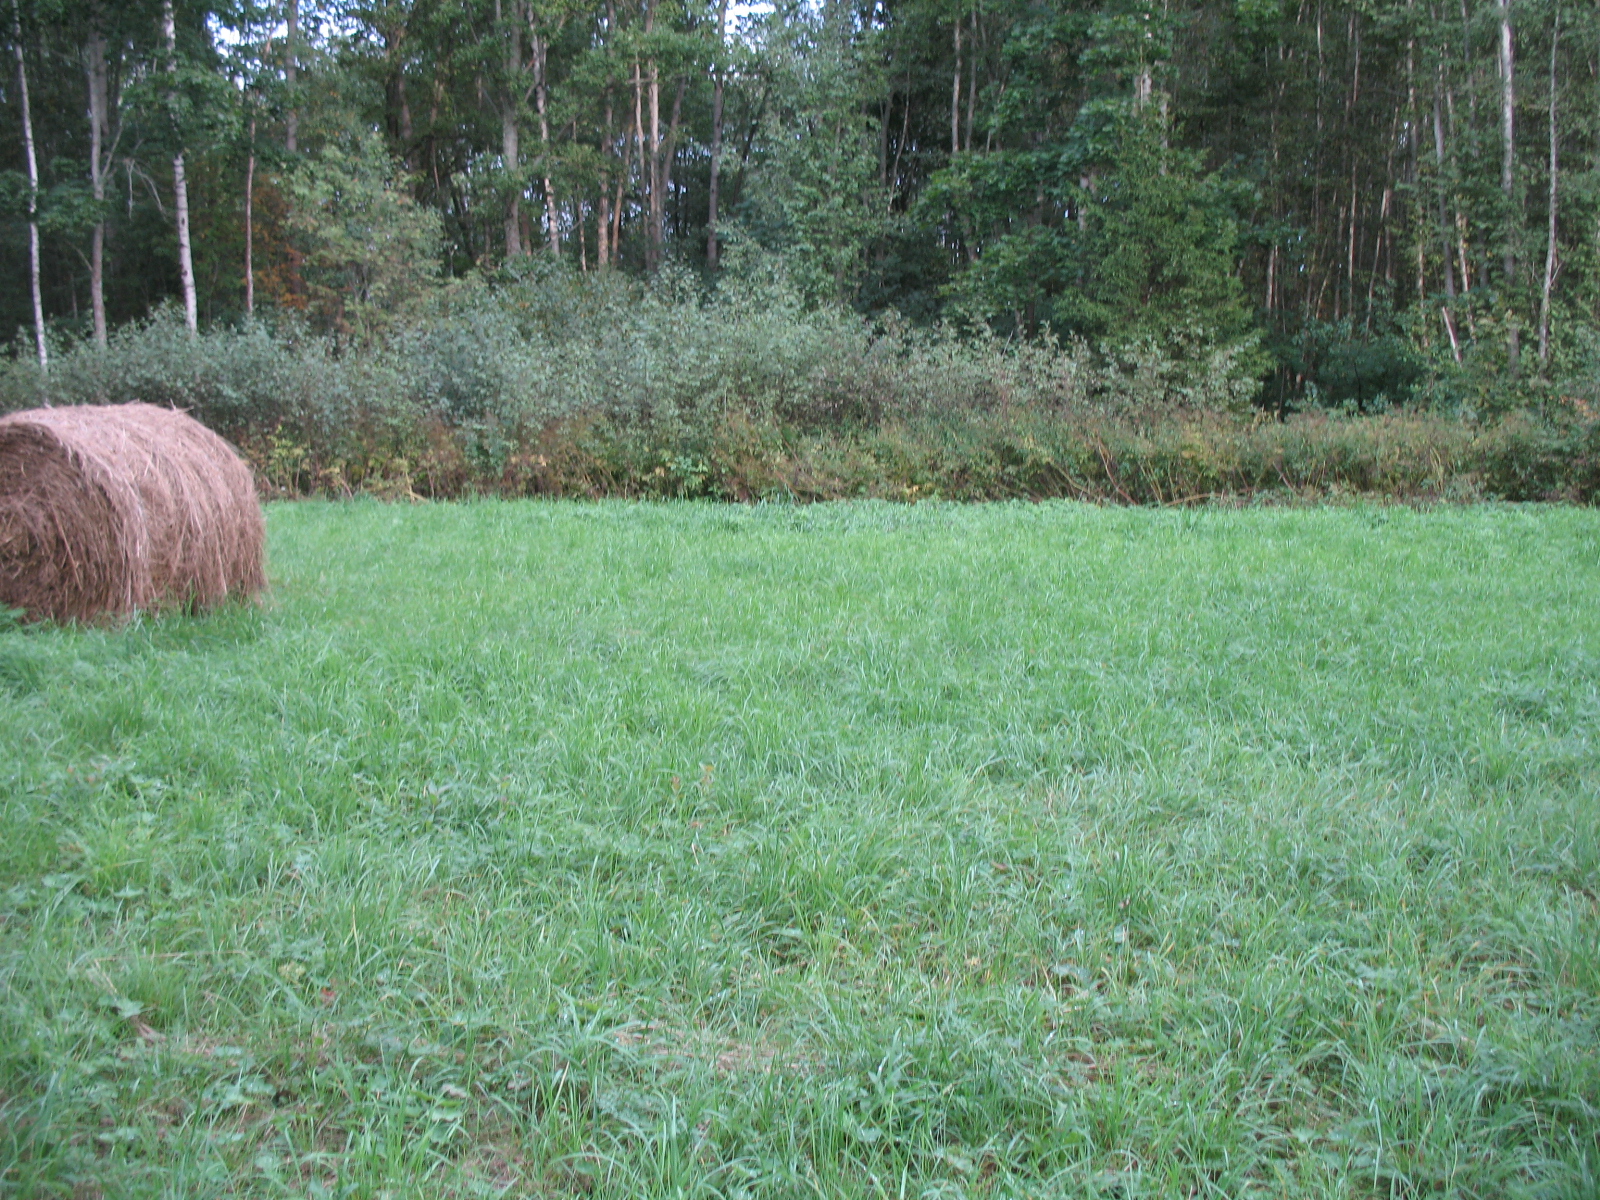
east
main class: Grassland
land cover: Grassland without tree/shrub cover
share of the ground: > 75 %
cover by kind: herbaceous plants 95 %, unconsolidated bare surface 5 %
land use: Agriculture (excluding fallow land and kitchen gardens)
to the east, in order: Grassland without tree/shrub cover; Broadleaved woodland; Grassland without tree/shrub cover; Ditches and canals; Grassland without tree/shrub cover; Broadleaved woodland; Grassland without tree/shrub cover
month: September
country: LV
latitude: 56.1063
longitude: 26.0385
